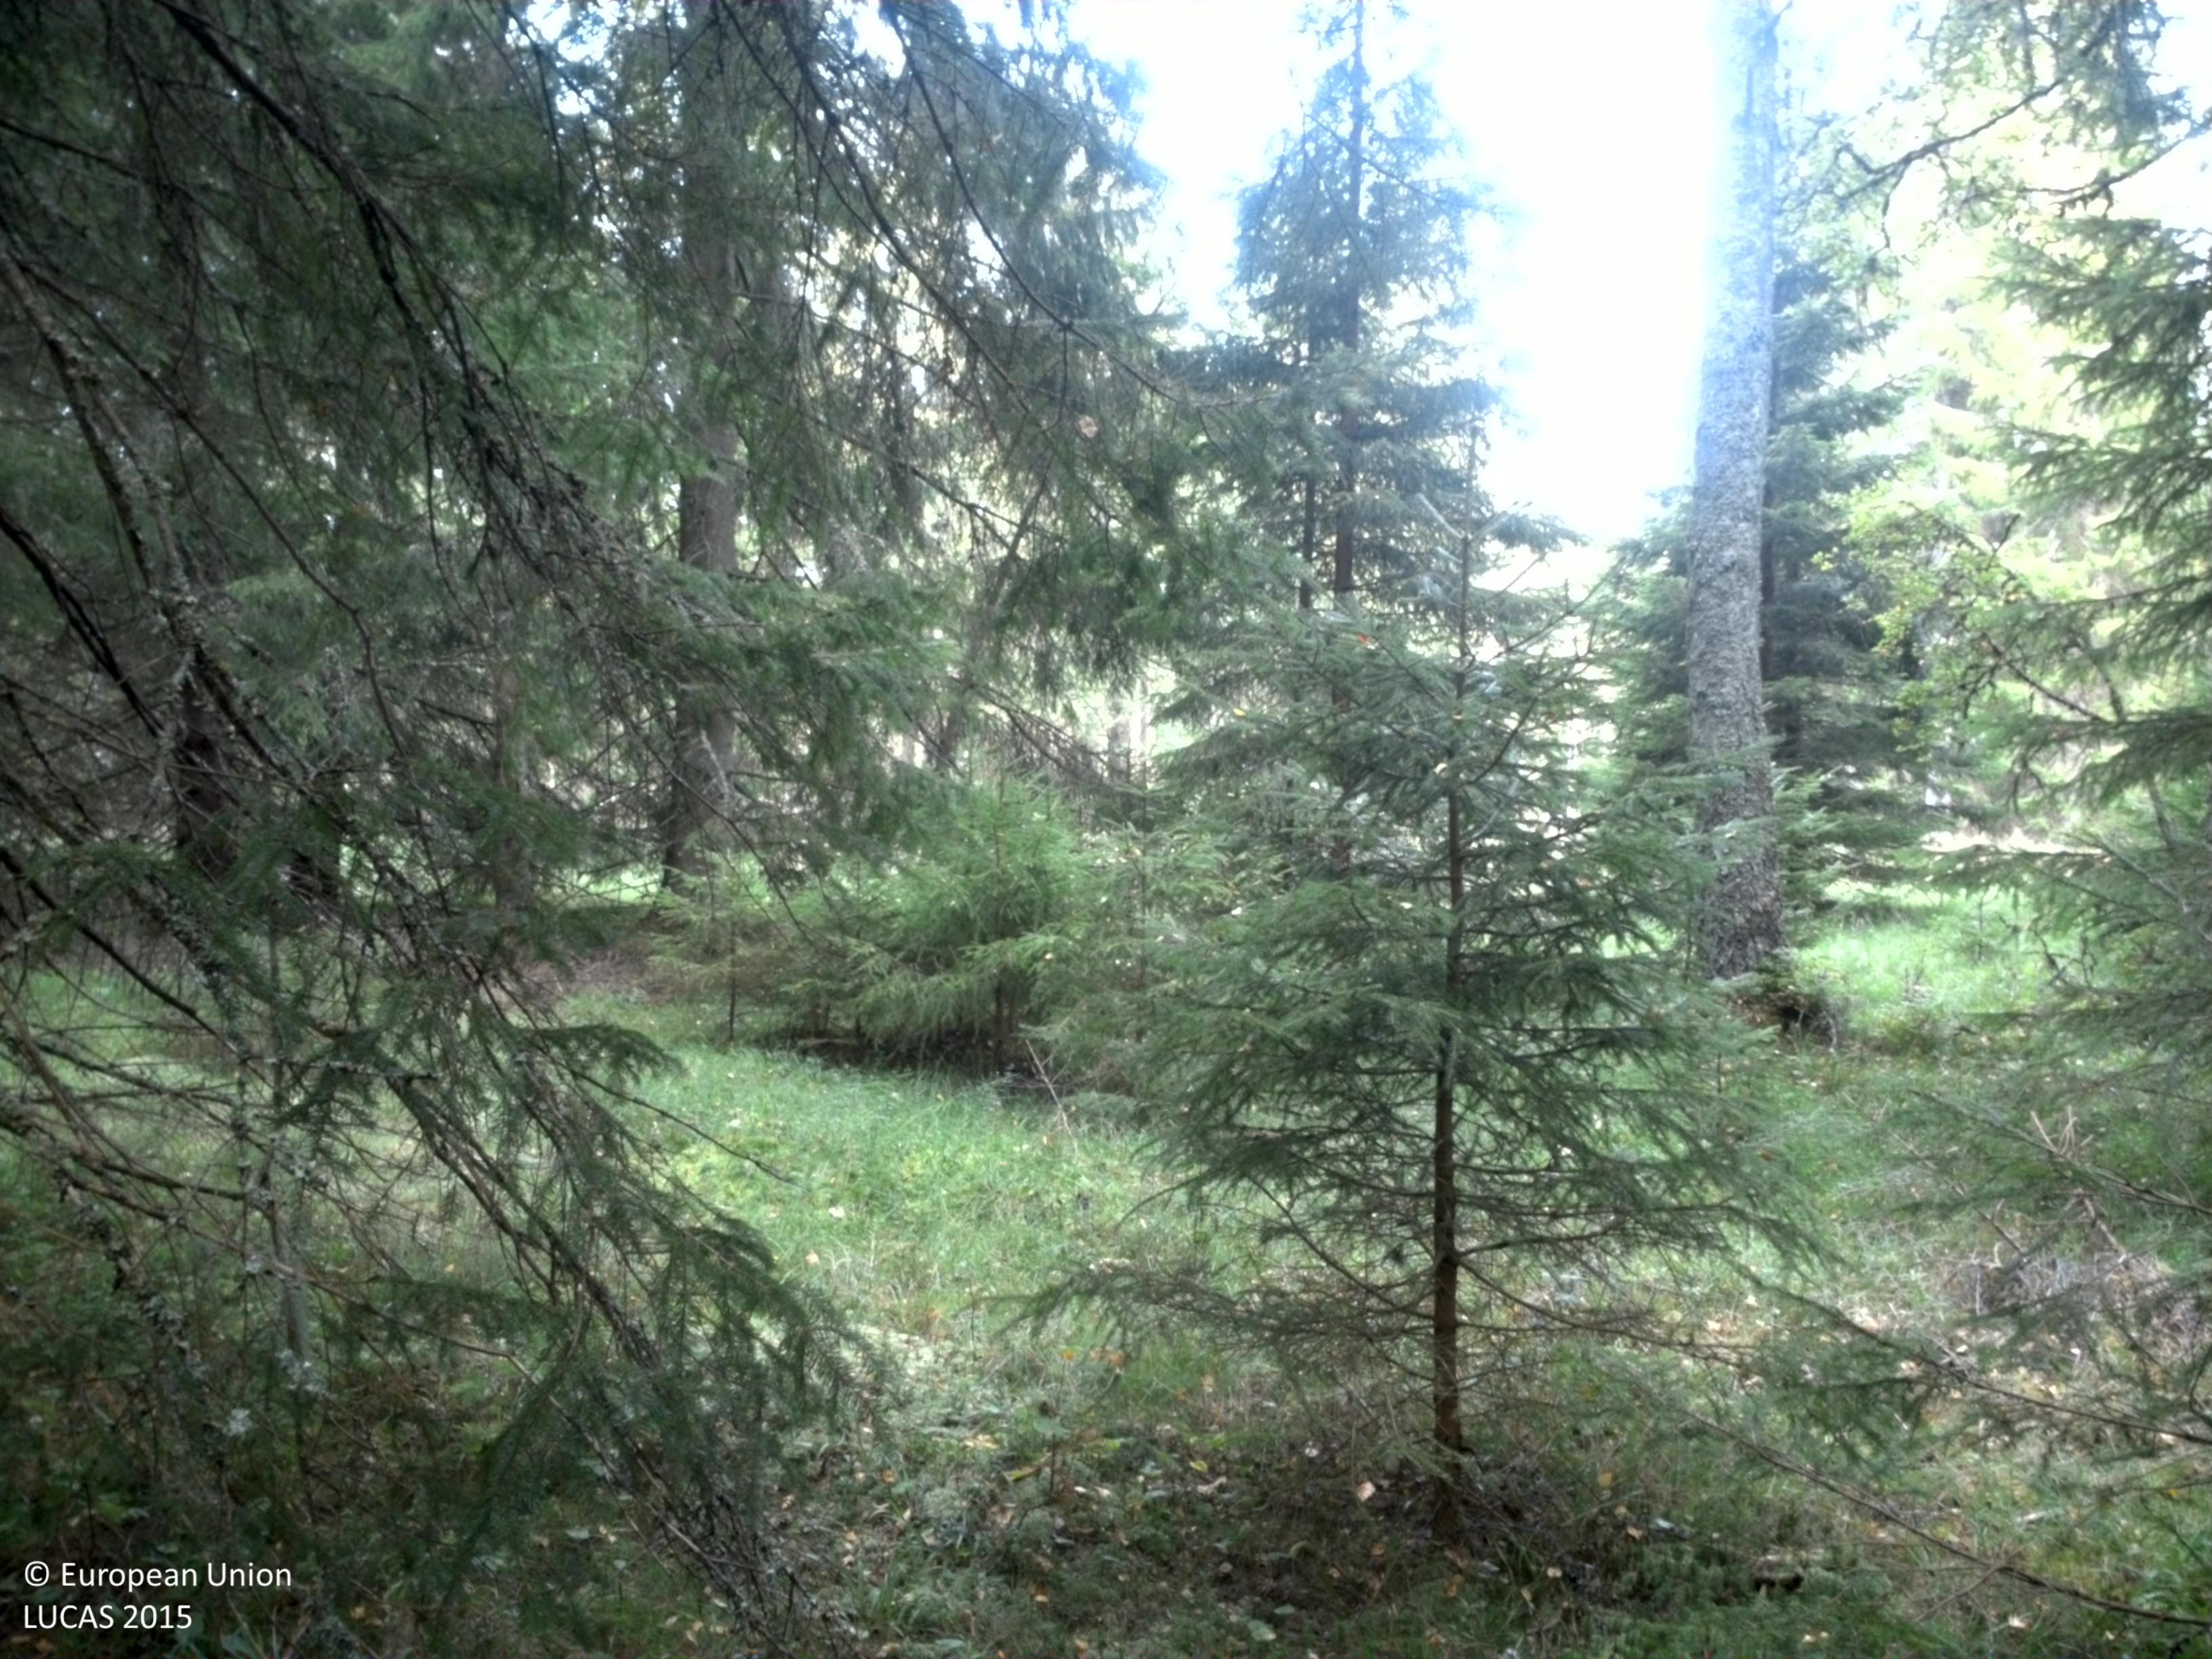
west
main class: Woodland
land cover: Spruce dominated coniferous woodland
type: boreal forest
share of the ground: 50 - 75 %
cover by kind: coniferous forest trees 70 %, unconsolidated bare surface 10 %, broadleaved forest trees 5 %, shrubs 5 %, herbaceous plants 5 %, lichens and mosses 5 %
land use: Forestry
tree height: > 5 m
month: August
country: SE
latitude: 58.0367
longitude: 13.9069
